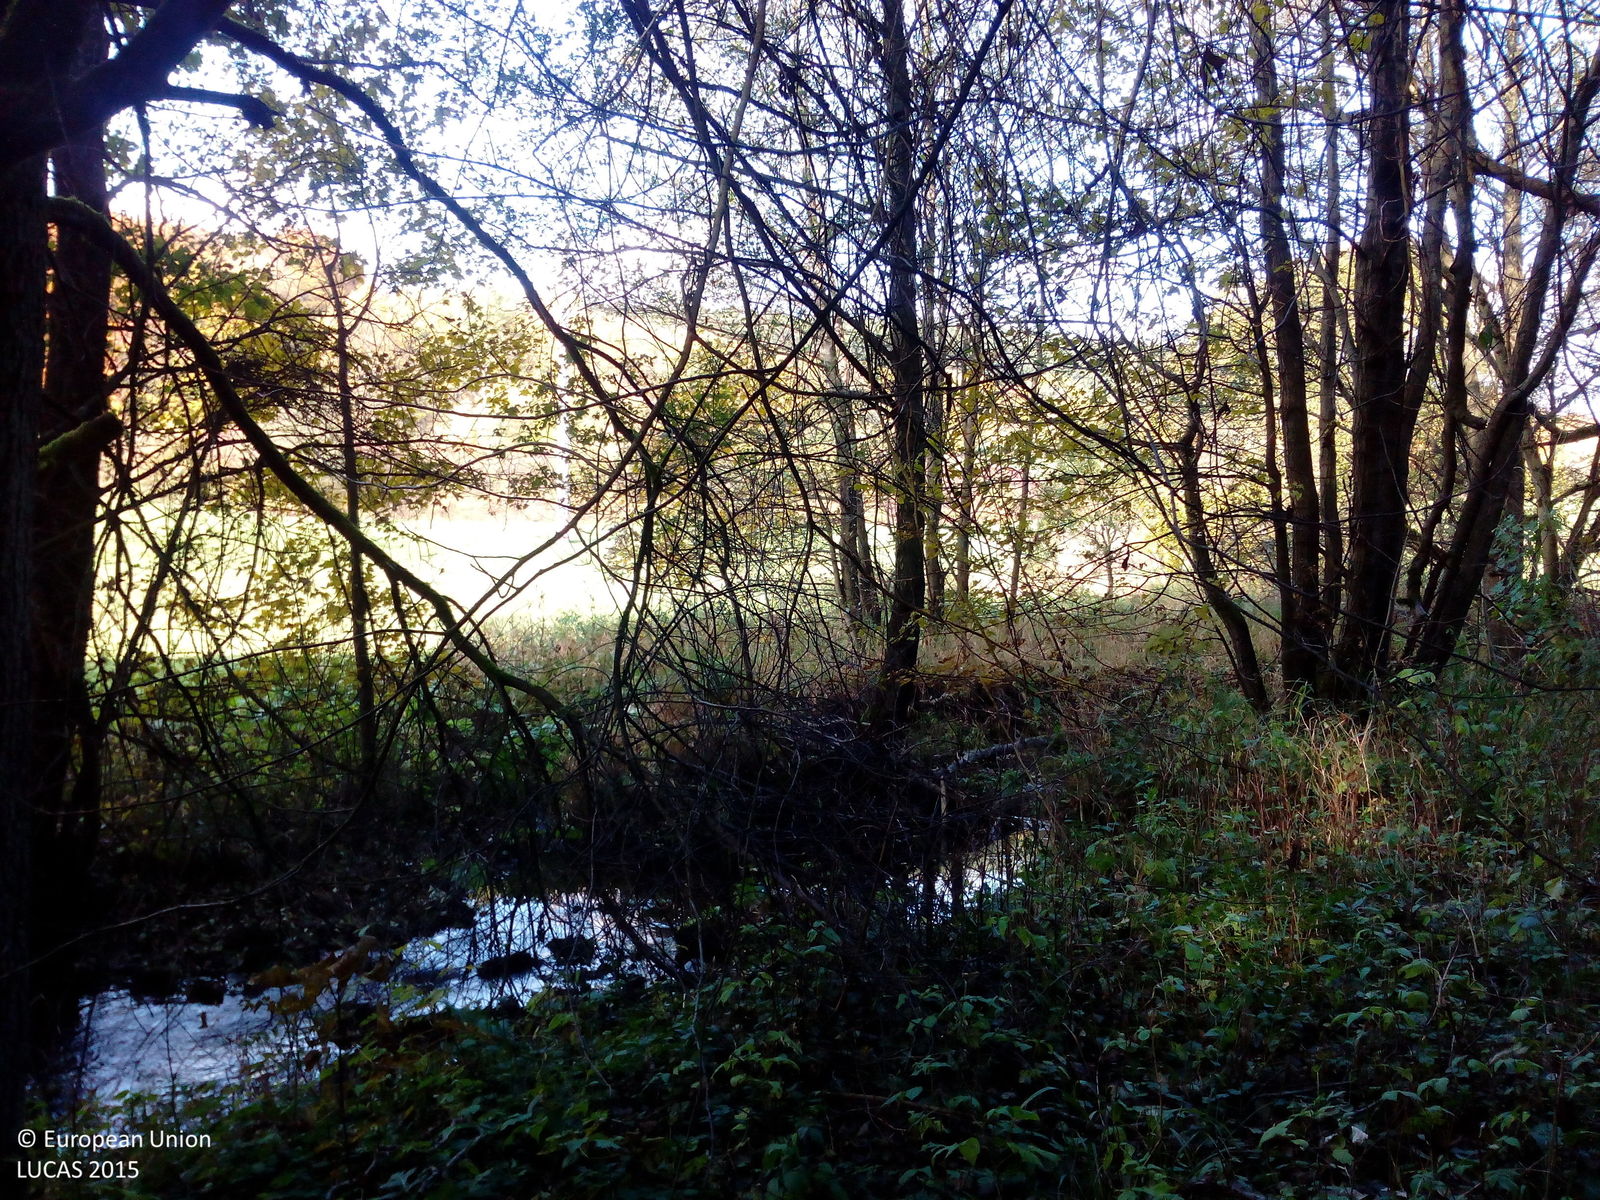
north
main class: Woodland
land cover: Broadleaved woodland
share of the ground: 50 - 75 %
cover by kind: broadleaved forest trees 45 %, coniferous forest trees 15 %, herbaceous plants 15 %, lichens and mosses 10 %, unconsolidated bare surface 10 %, shrubs 5 %
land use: Forestry
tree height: > 5 m
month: October
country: DE
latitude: 50.3820
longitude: 9.9297
